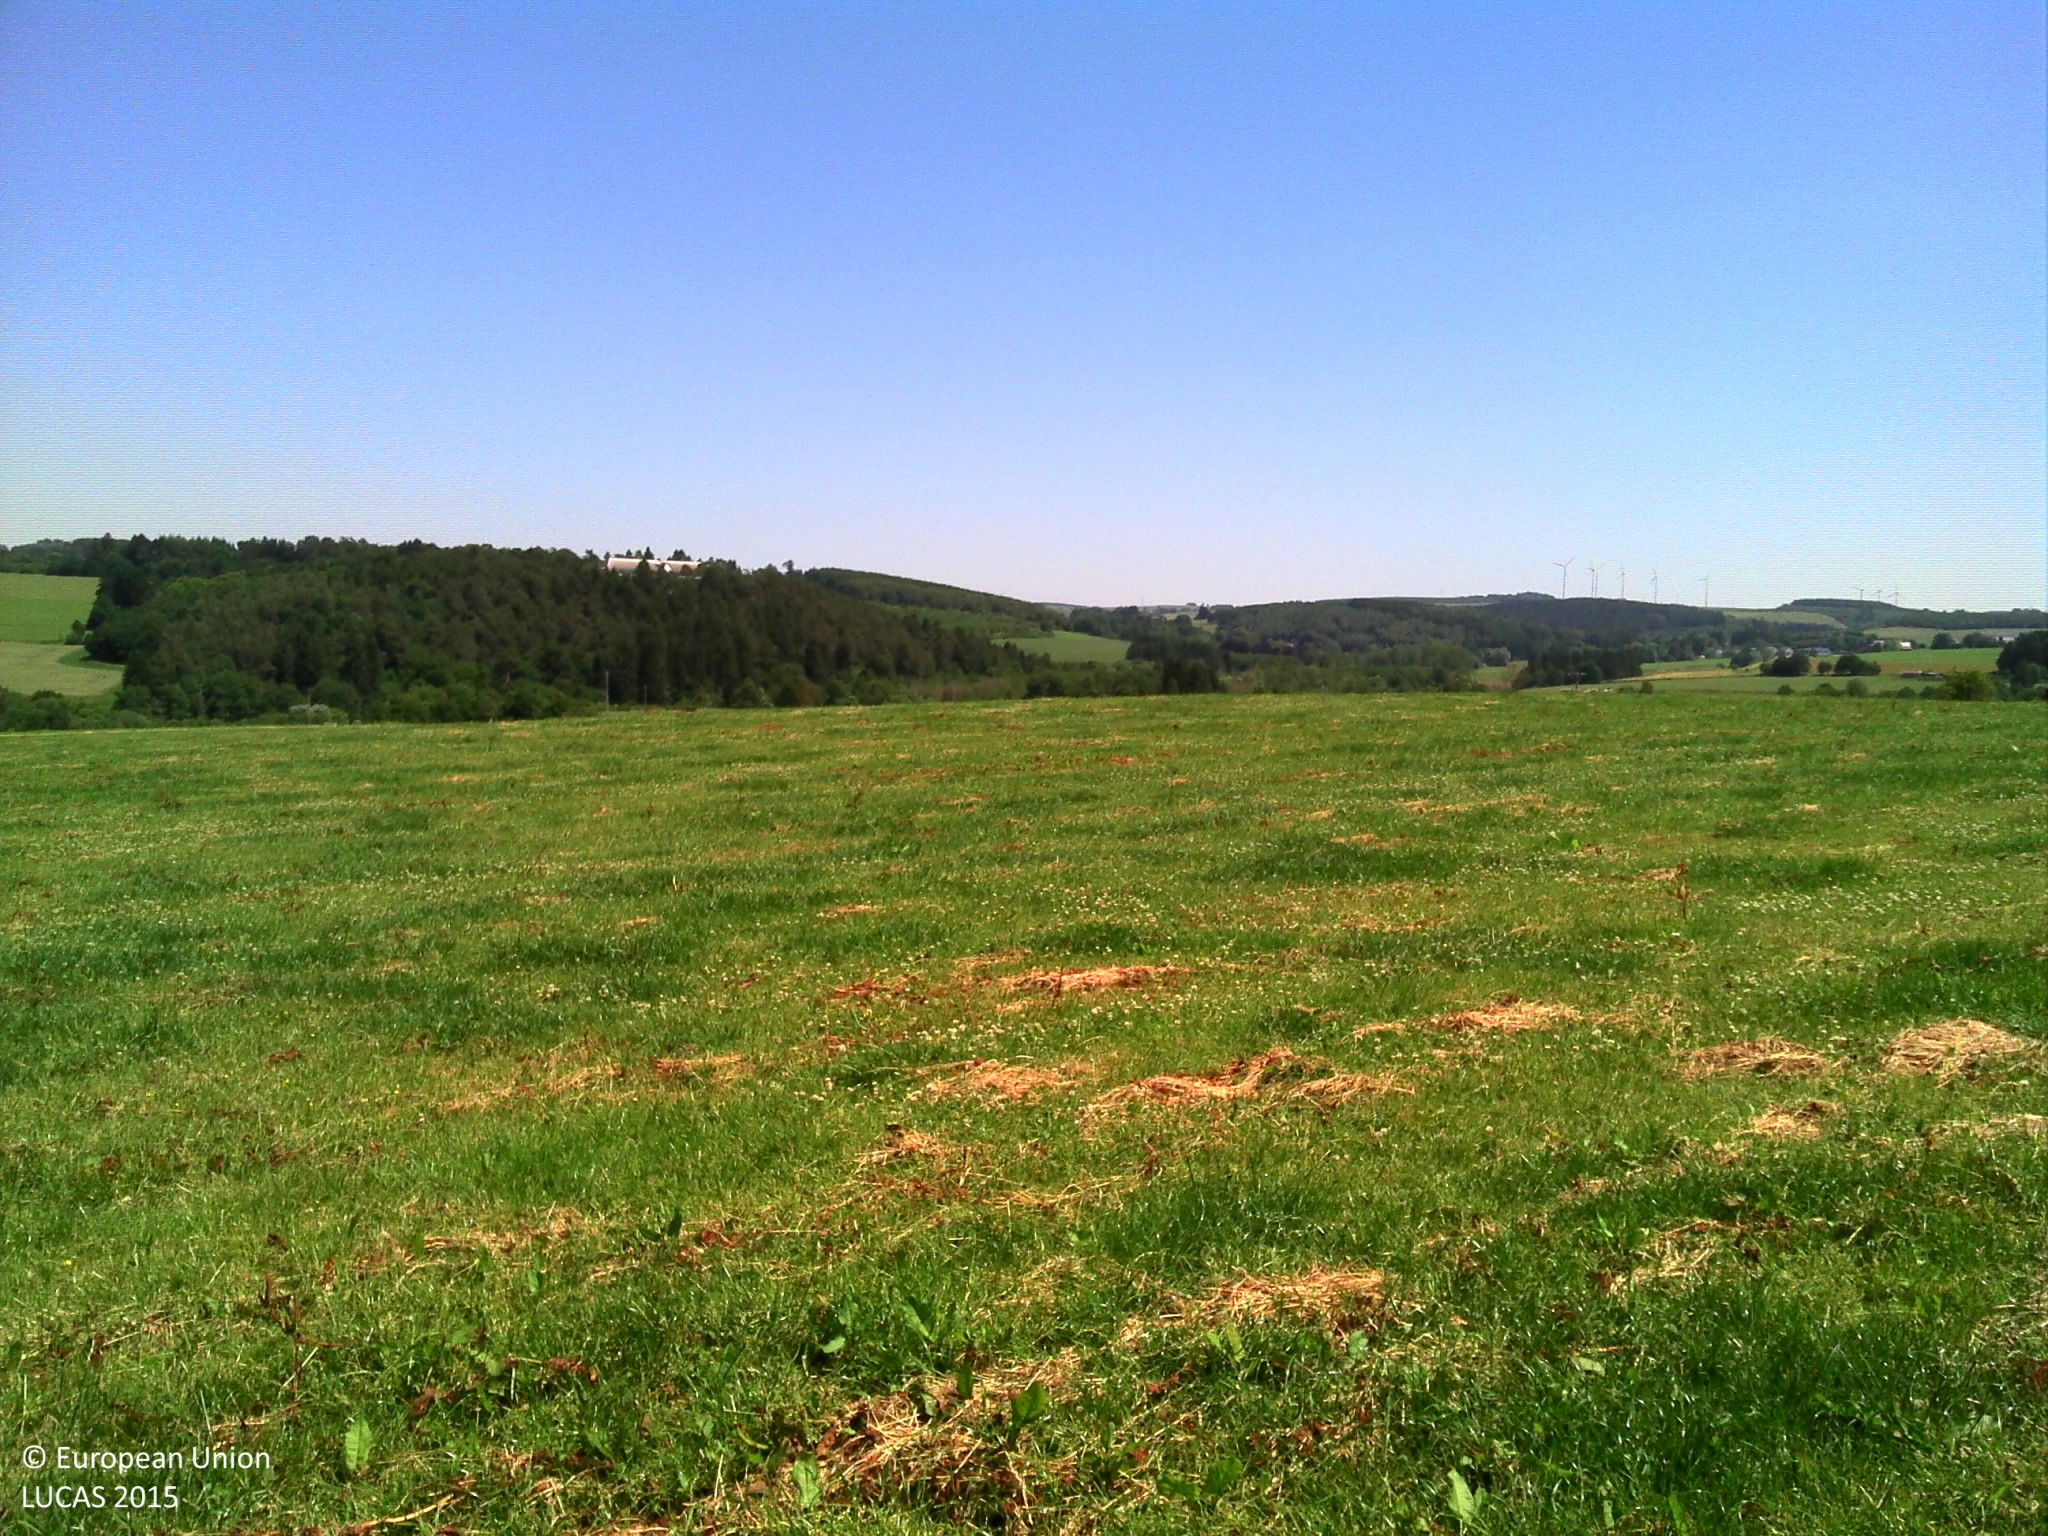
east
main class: Grassland
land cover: Grassland without tree/shrub cover
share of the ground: > 75 %
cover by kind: herbaceous plants 100 %
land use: Agriculture (excluding fallow land and kitchen gardens)
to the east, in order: Grassland without tree/shrub cover; Fences; Grassland without tree/shrub cover
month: June
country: BE
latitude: 50.0421
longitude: 5.5161
